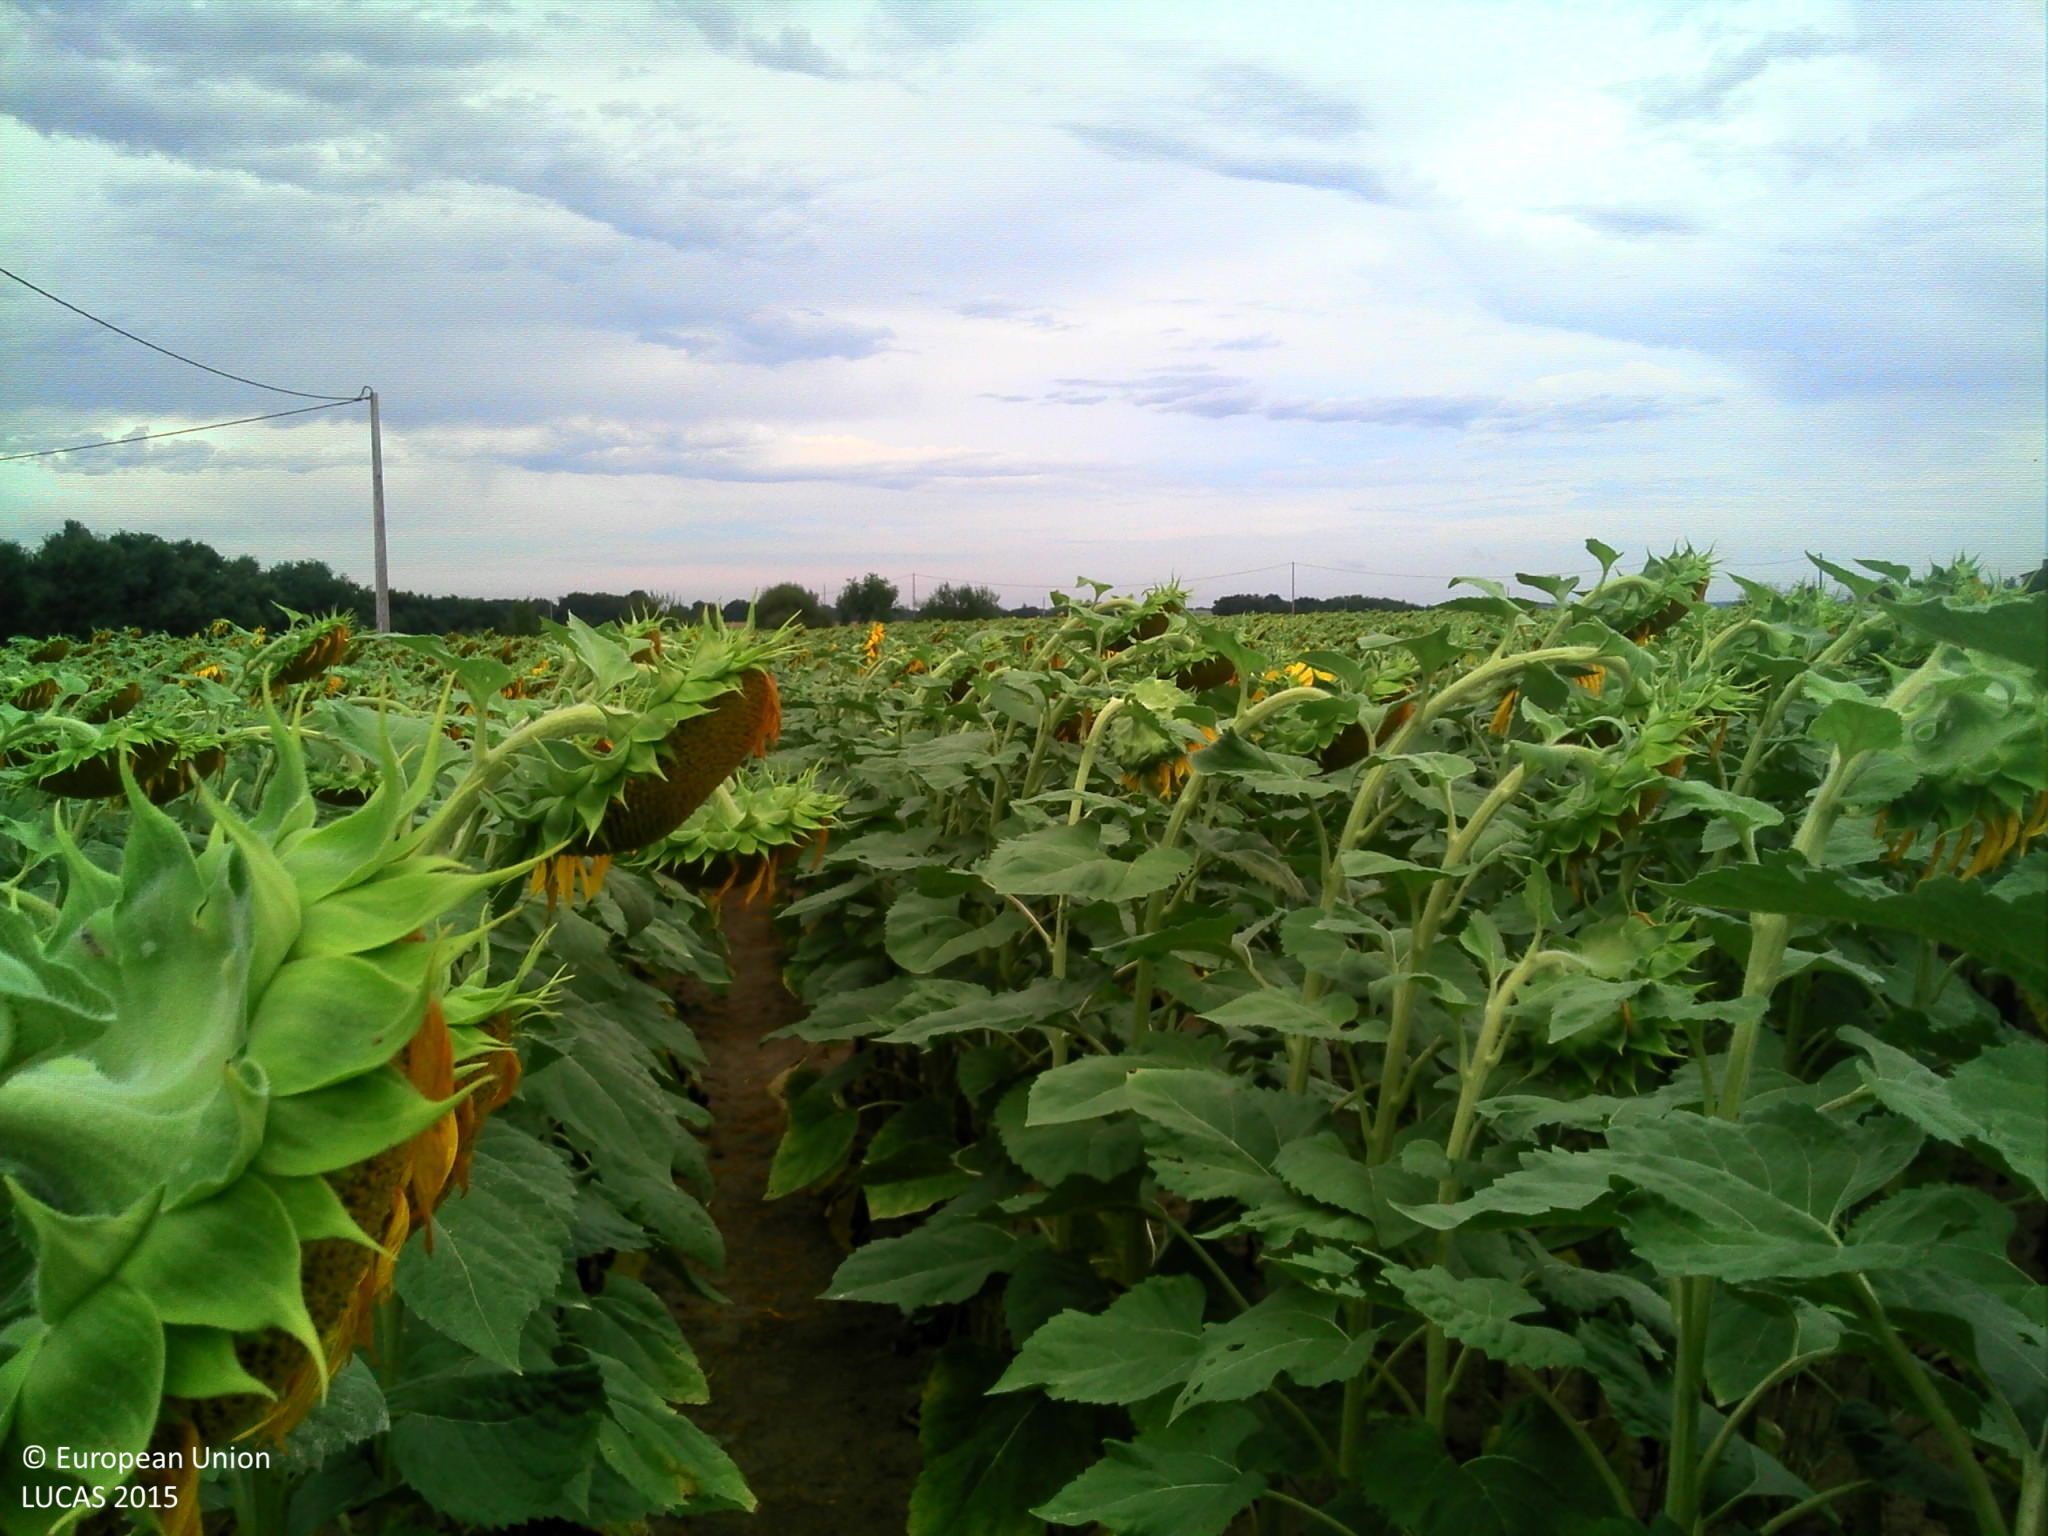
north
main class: Cropland
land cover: Sunflower
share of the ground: > 75 %
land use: Agriculture (excluding fallow land and kitchen gardens)
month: July
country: FR
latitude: 43.2302
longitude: 1.1752
